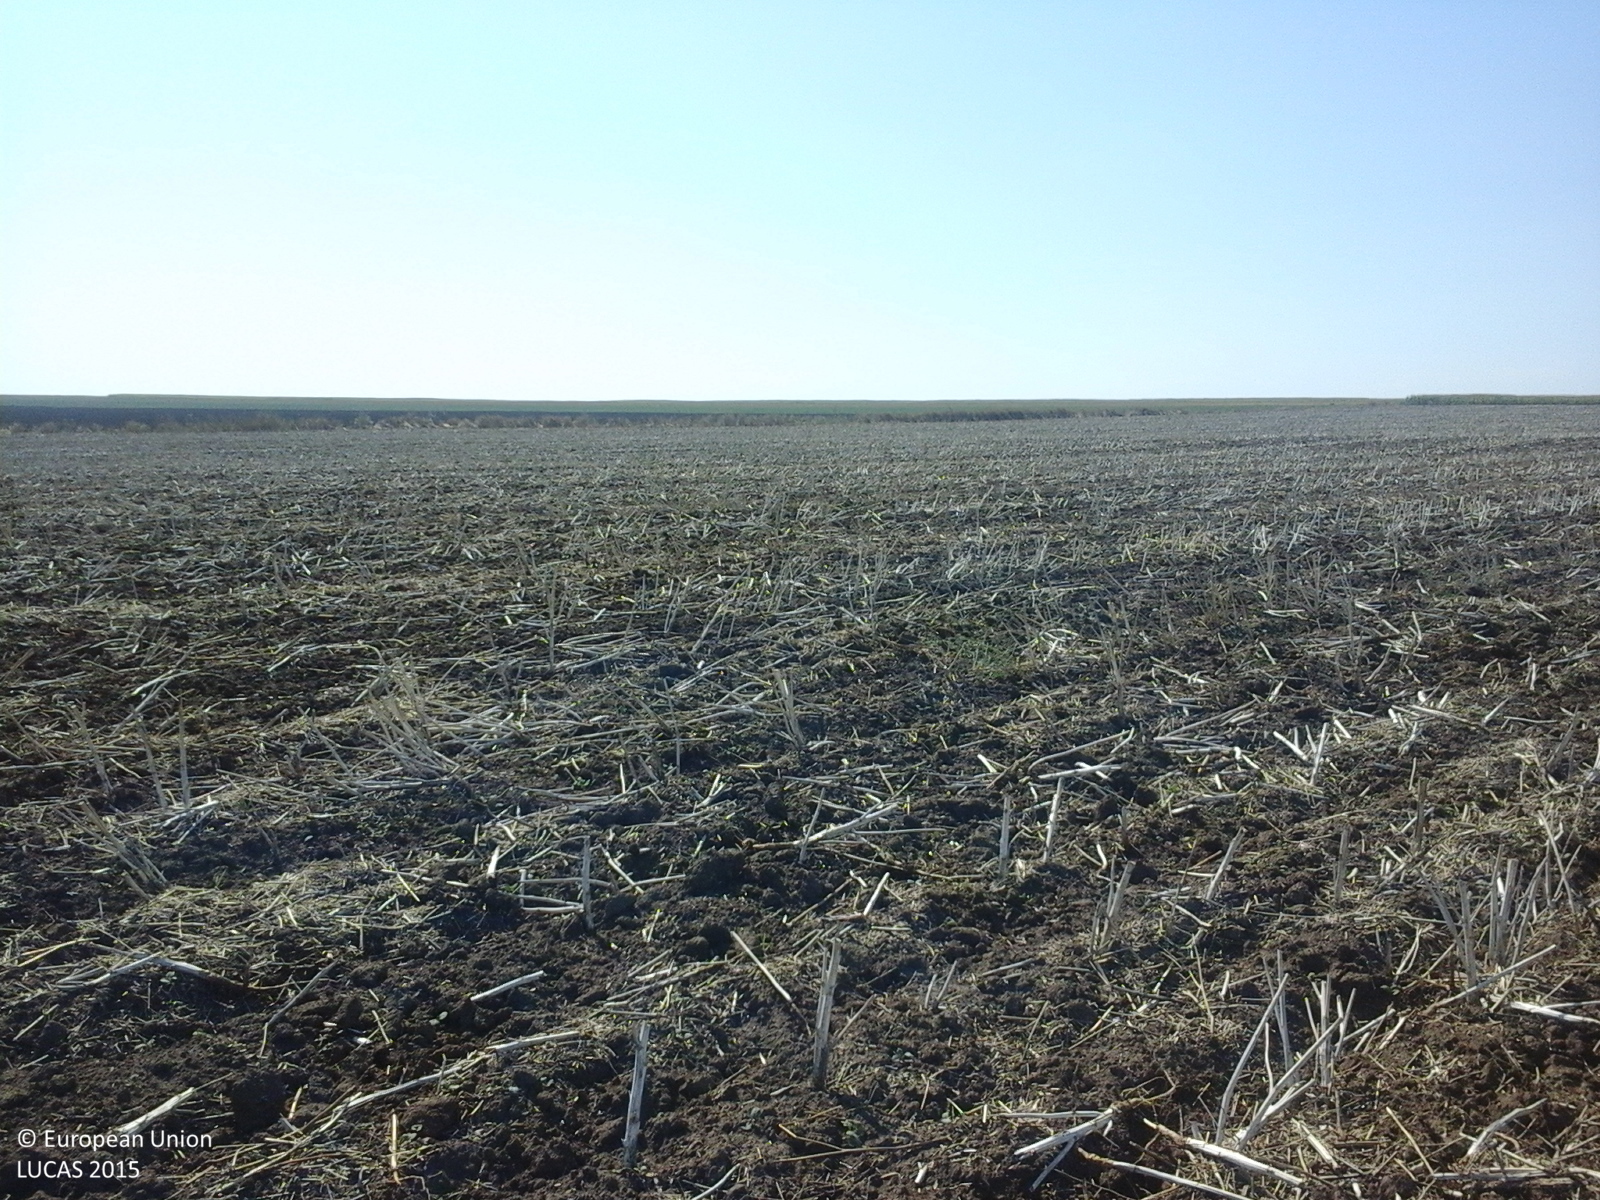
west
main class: Cropland
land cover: Rape and turnip rape
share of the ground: 10 - 25 %
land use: Agriculture (excluding fallow land and kitchen gardens)
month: August
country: RO
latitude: 44.2540
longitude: 28.4161
